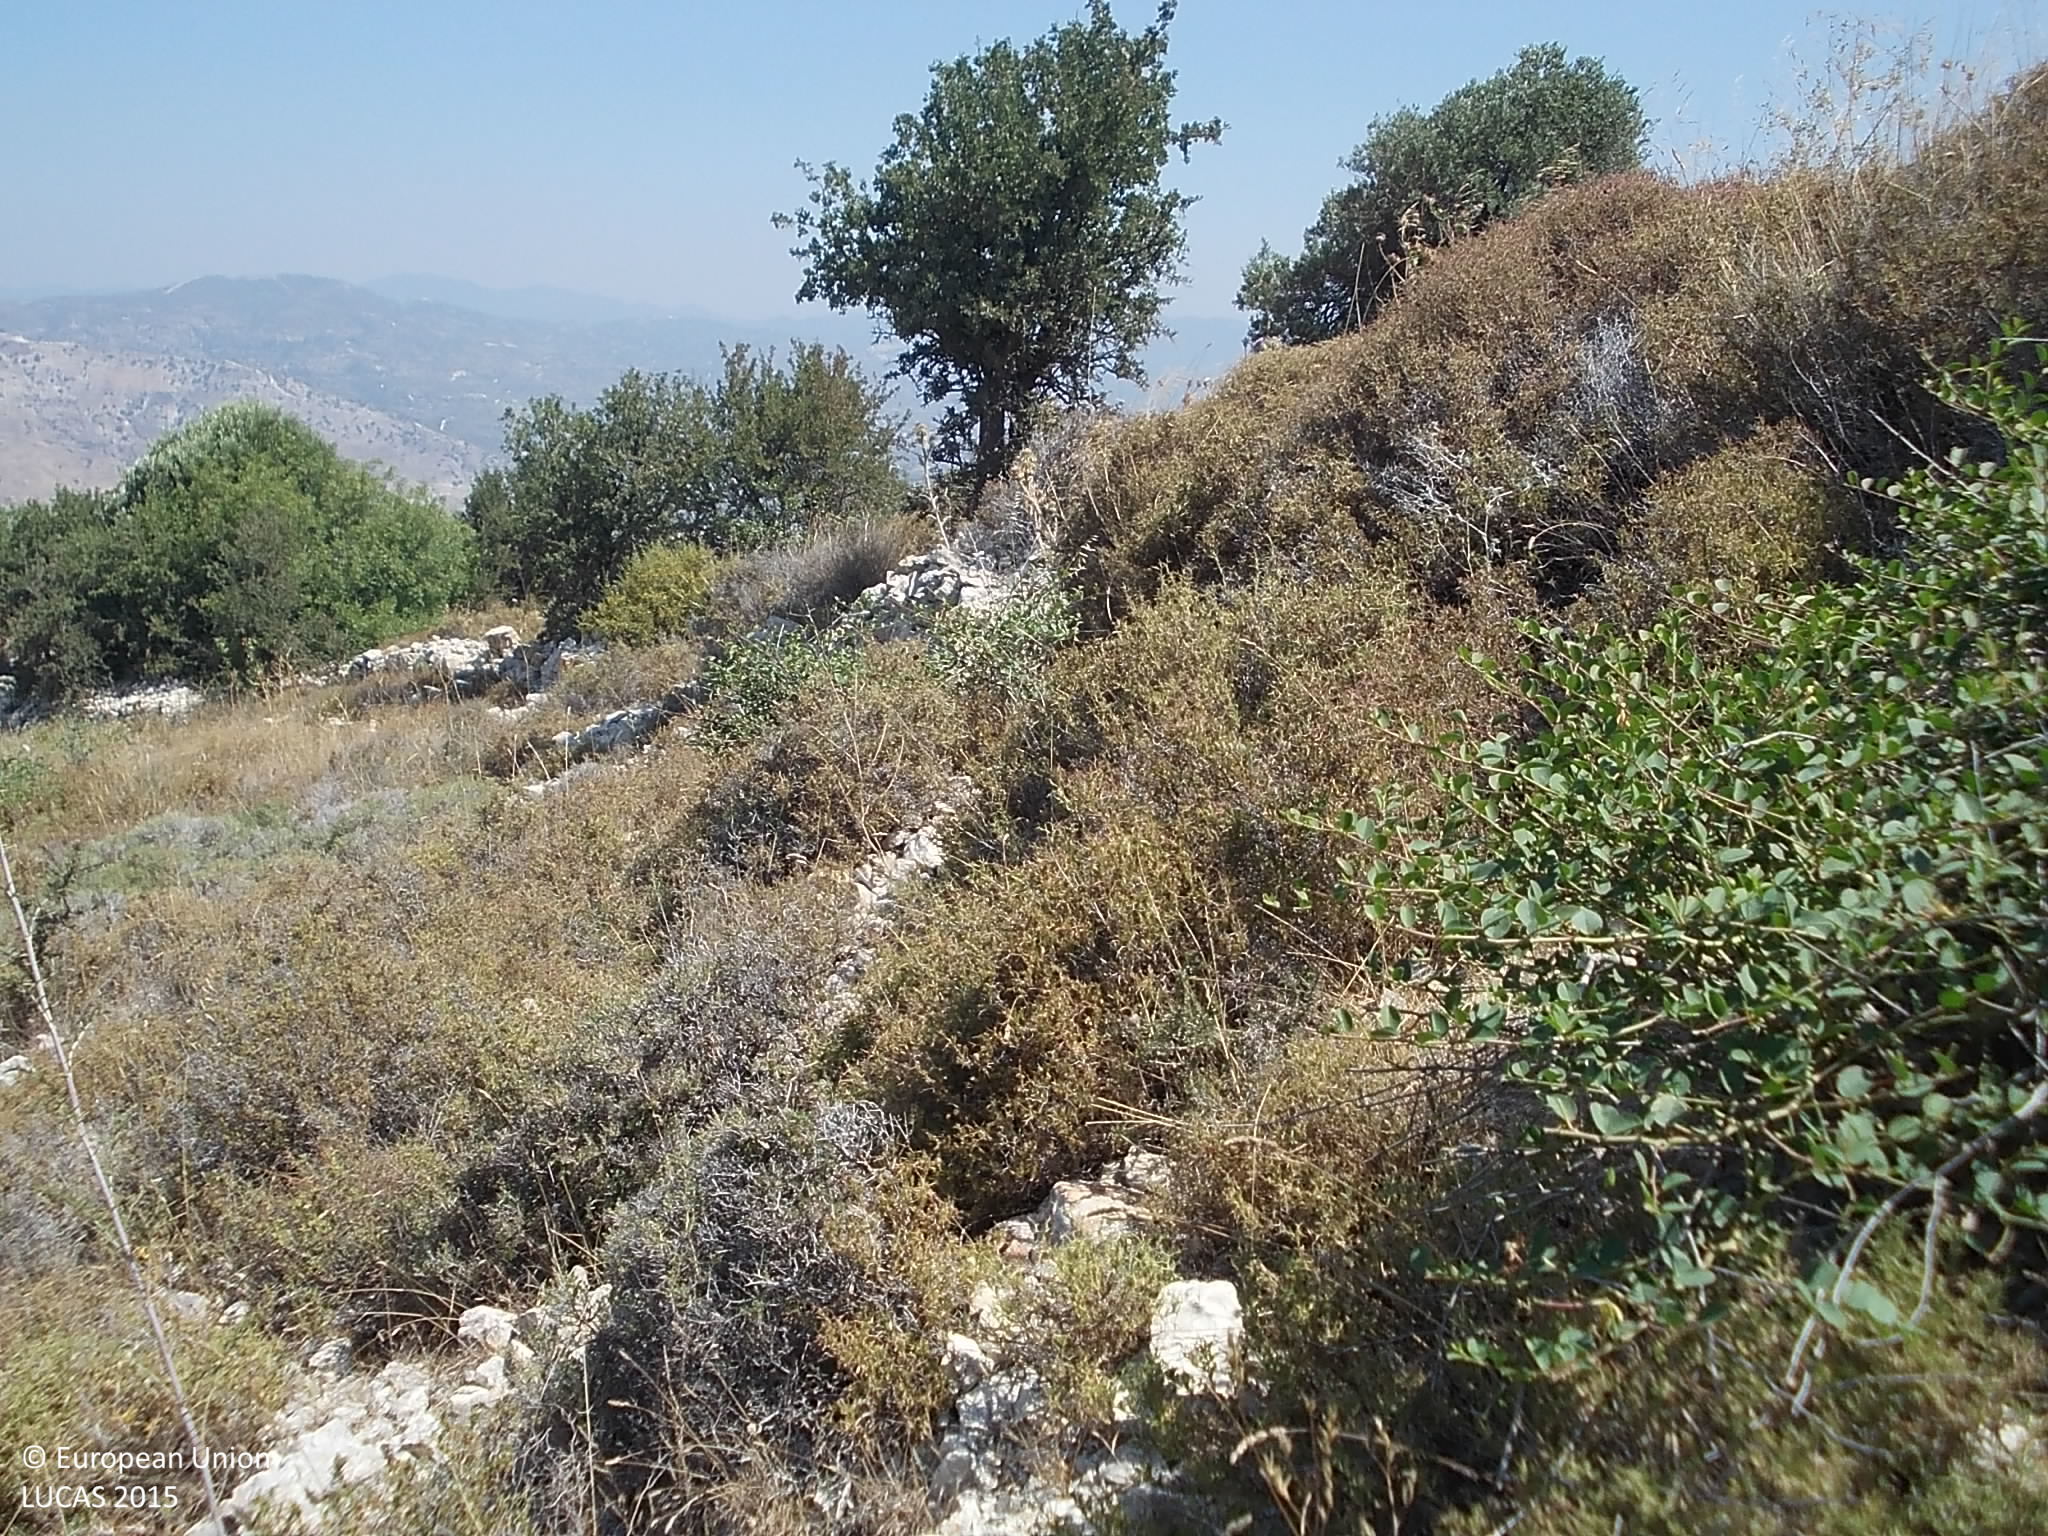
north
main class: Shrubland
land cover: Shrubland without tree cover
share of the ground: 50 - 75 %
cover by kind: shrubs 70 %, herbaceous plants 20 %, unconsolidated bare surface 10 %
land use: Semi-natural and natural areas not in use
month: July
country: CY
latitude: 34.7891
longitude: 32.7242
